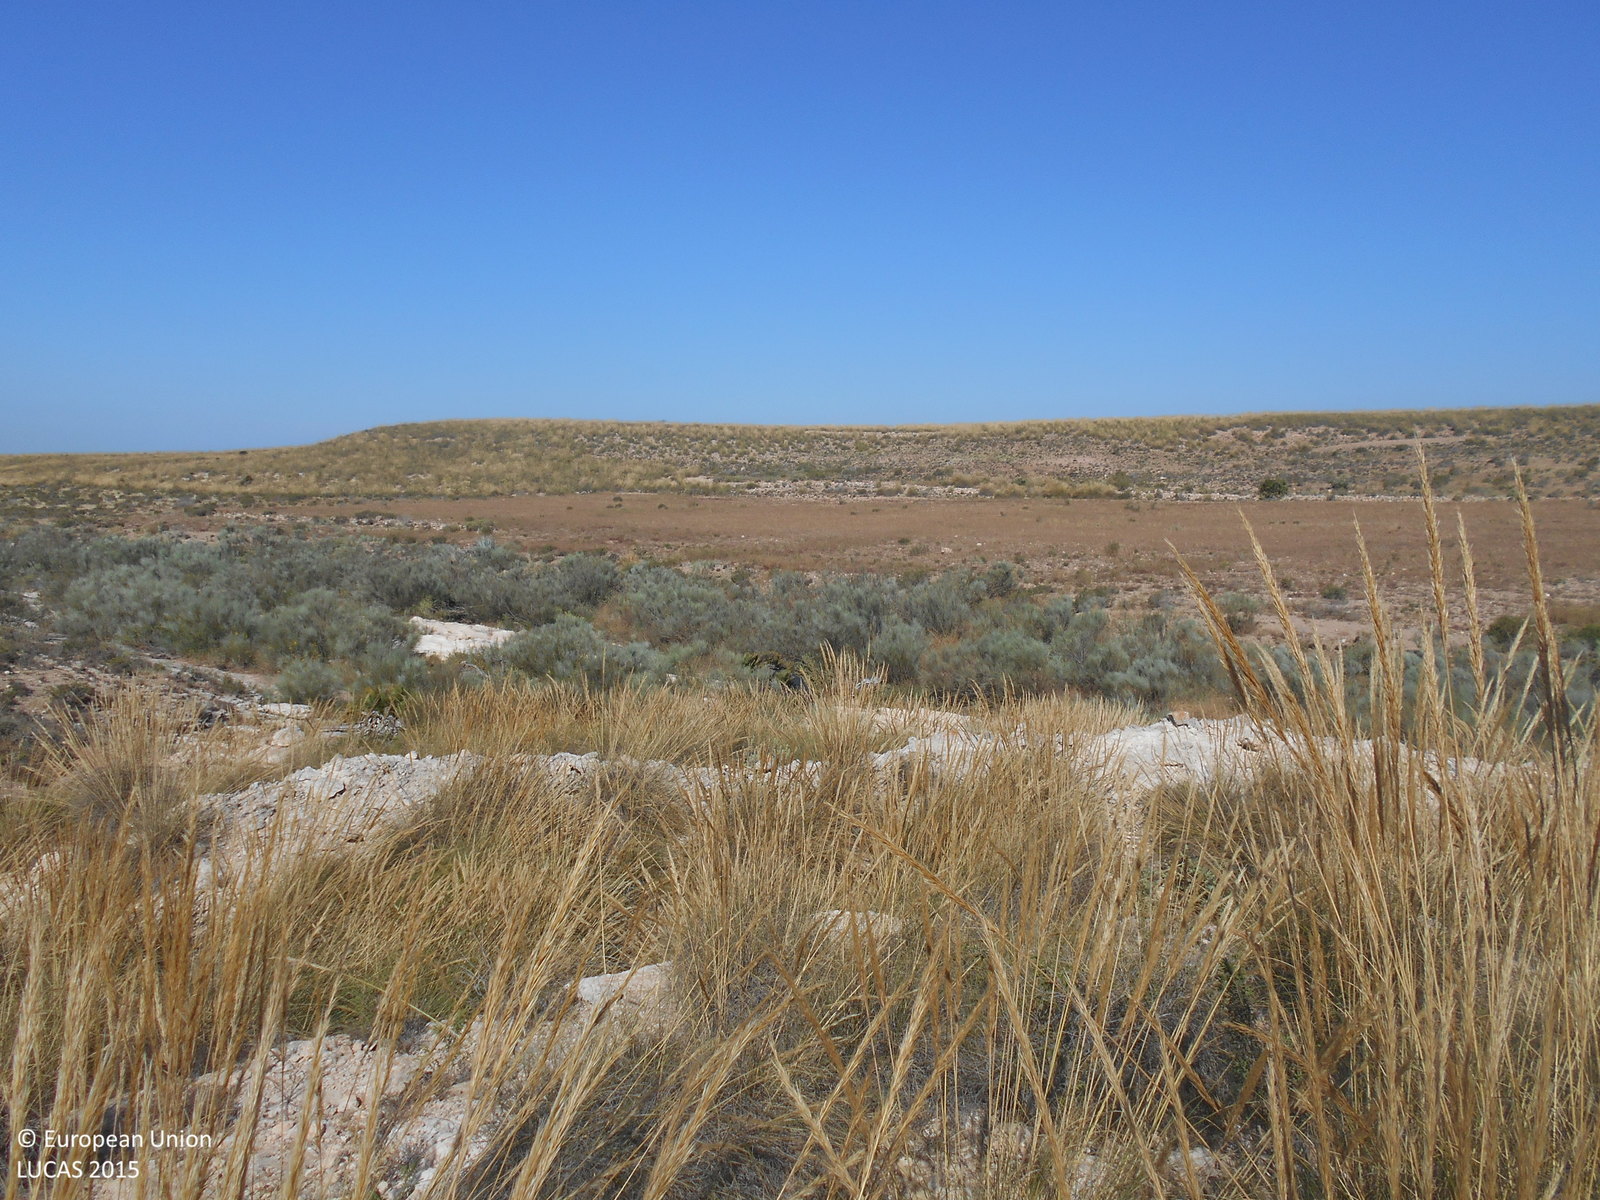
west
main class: Shrubland
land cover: Shrubland without tree cover
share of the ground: 25 - 50 %
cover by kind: shrubs 30 %, consolidated bare surface 30 %, unconsolidated bare surface 30 %, herbaceous plants 10 %
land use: Semi-natural and natural areas not in use
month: May
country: ES
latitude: 36.8592
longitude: -2.1208
